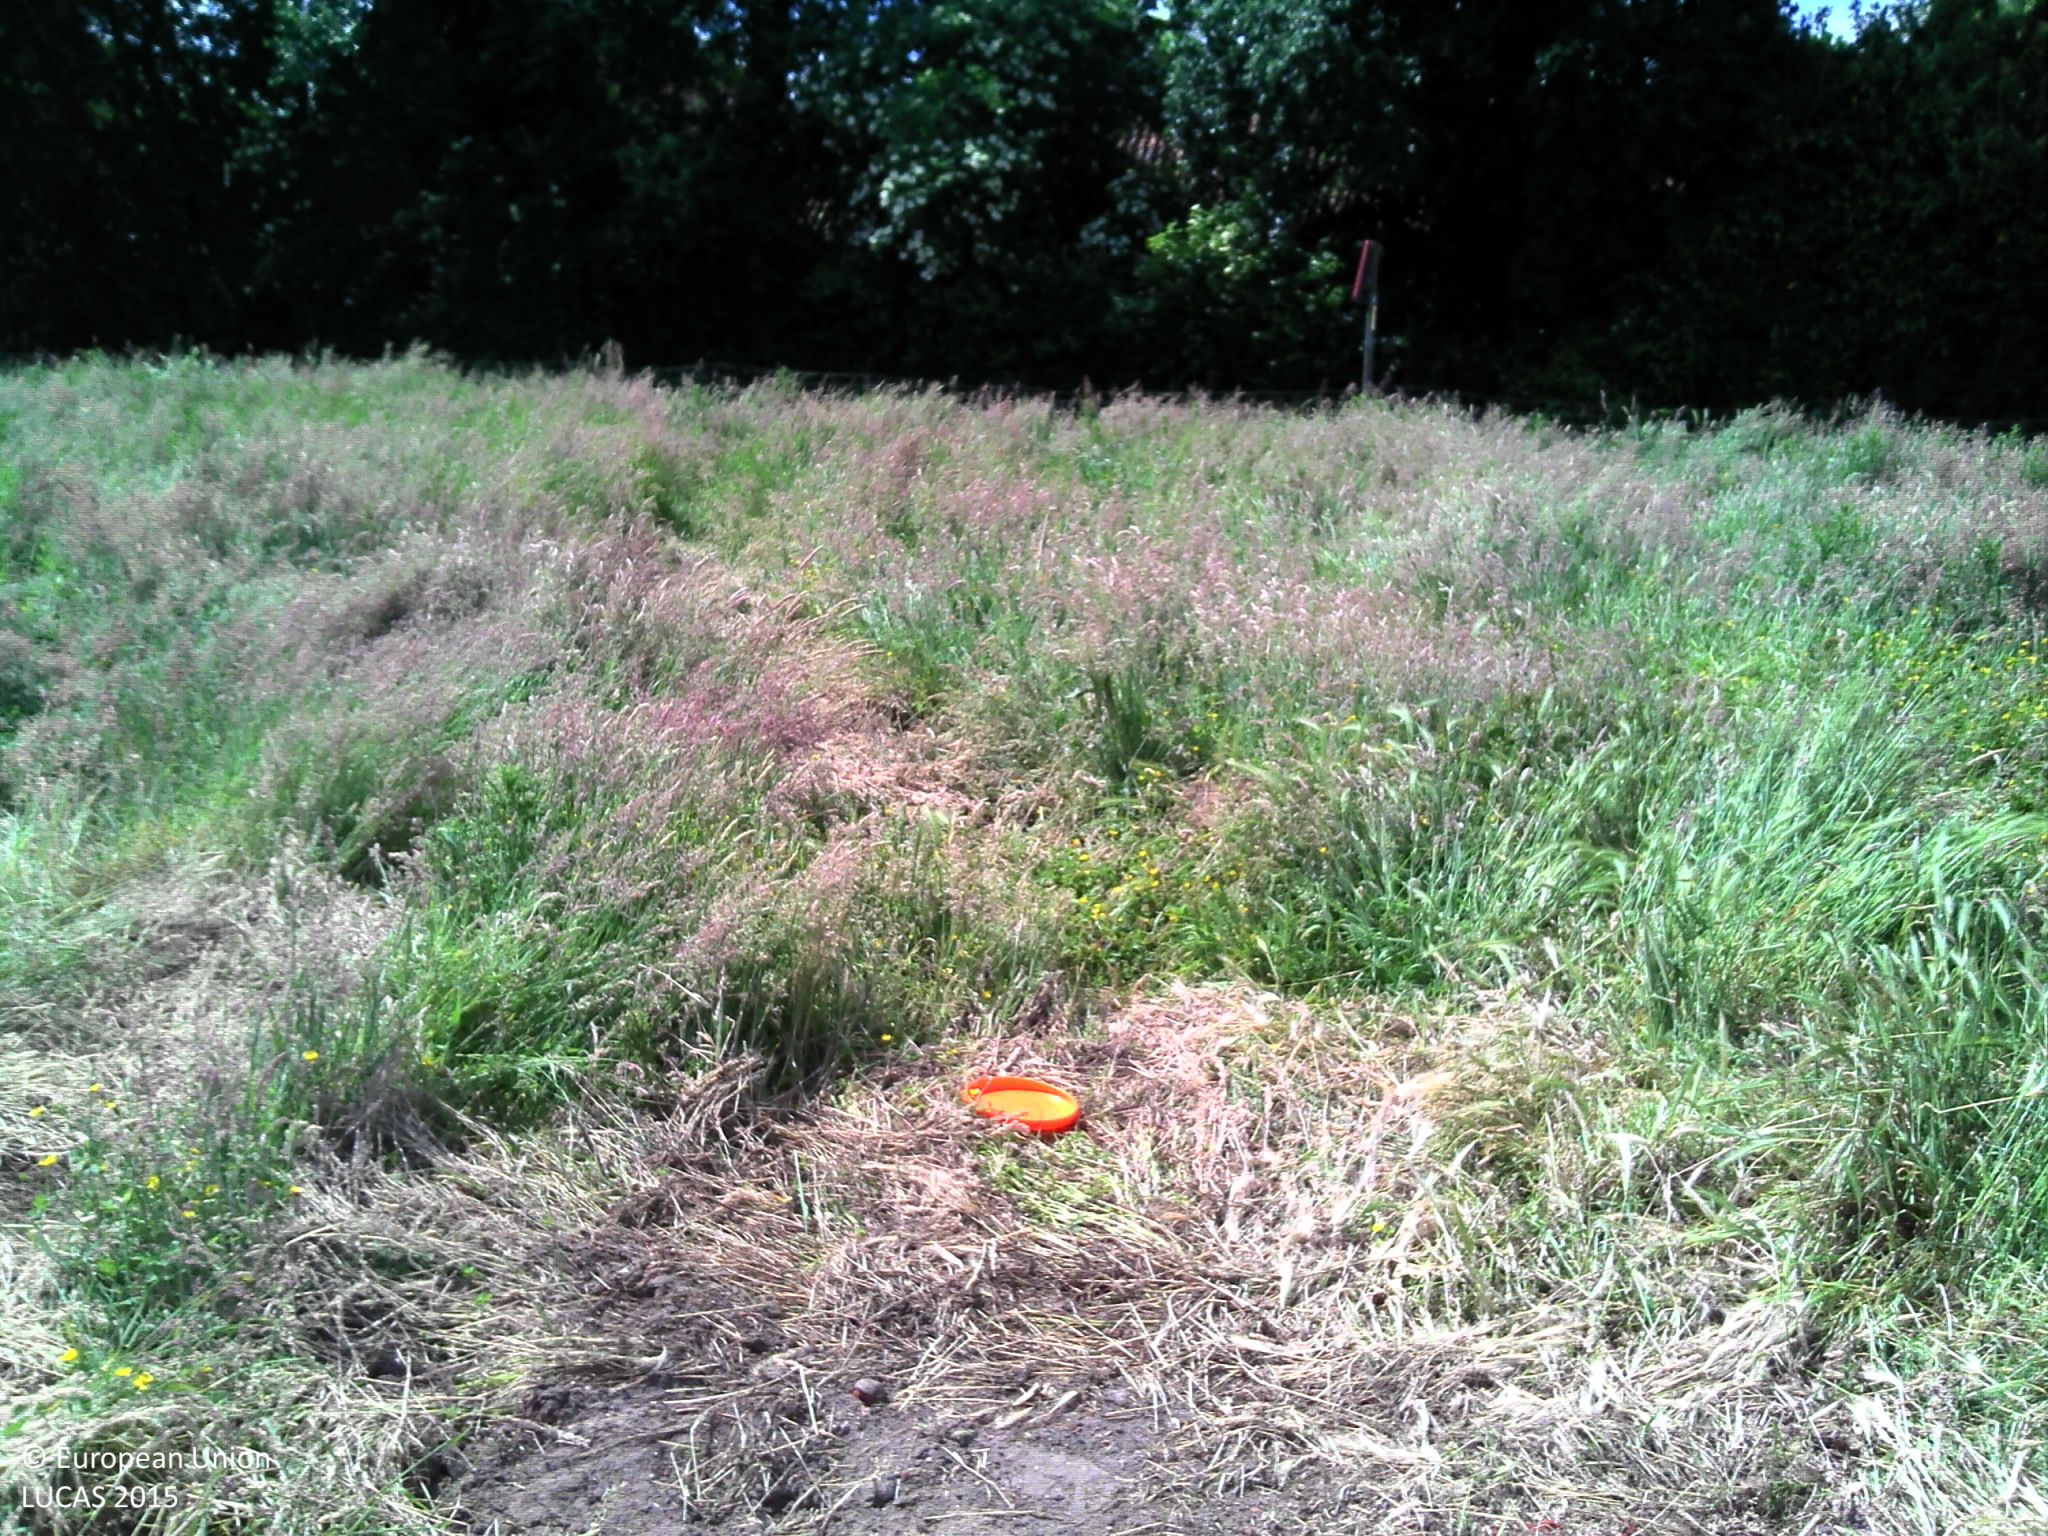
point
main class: Grassland
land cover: Grassland without tree/shrub cover
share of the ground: > 75 %
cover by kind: herbaceous plants 100 %
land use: Residential
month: June
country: BE
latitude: 50.9262
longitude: 3.6332
